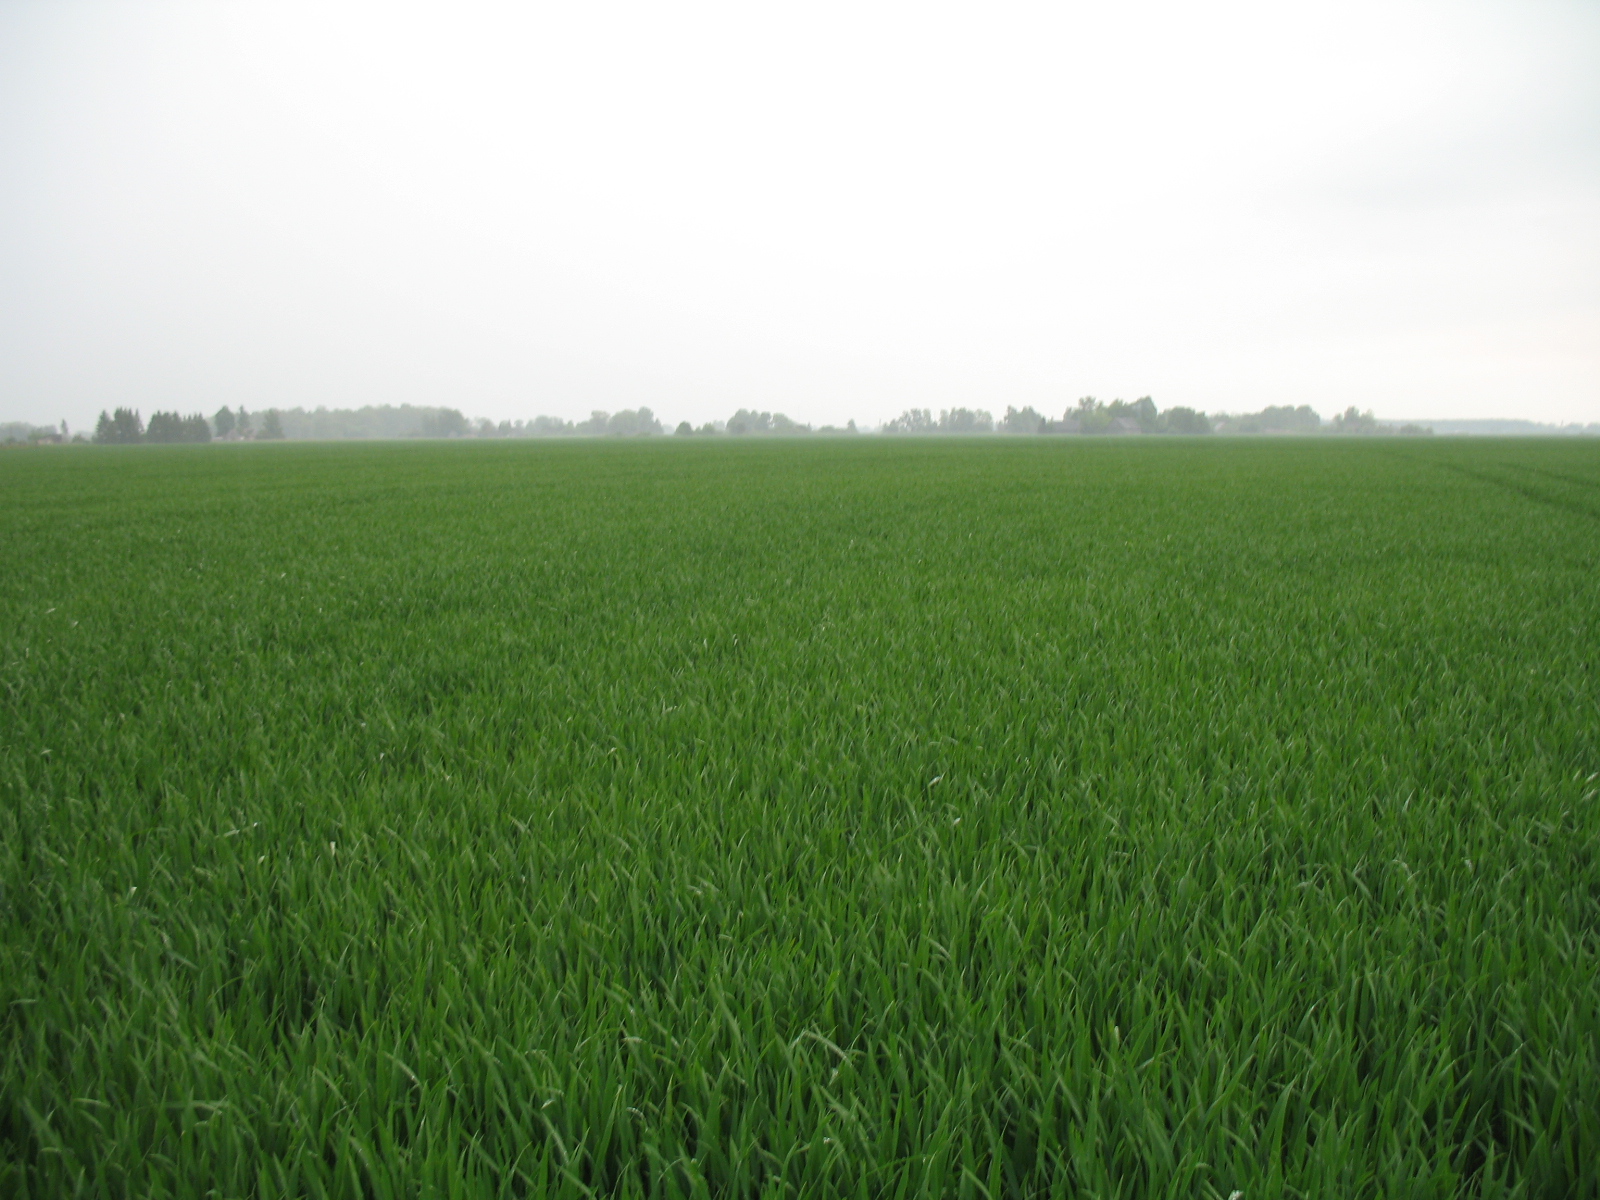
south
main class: Cropland
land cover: Common wheat
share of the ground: > 75 %
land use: Agriculture (excluding fallow land and kitchen gardens)
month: May
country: LV
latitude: 56.7308
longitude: 23.4930
